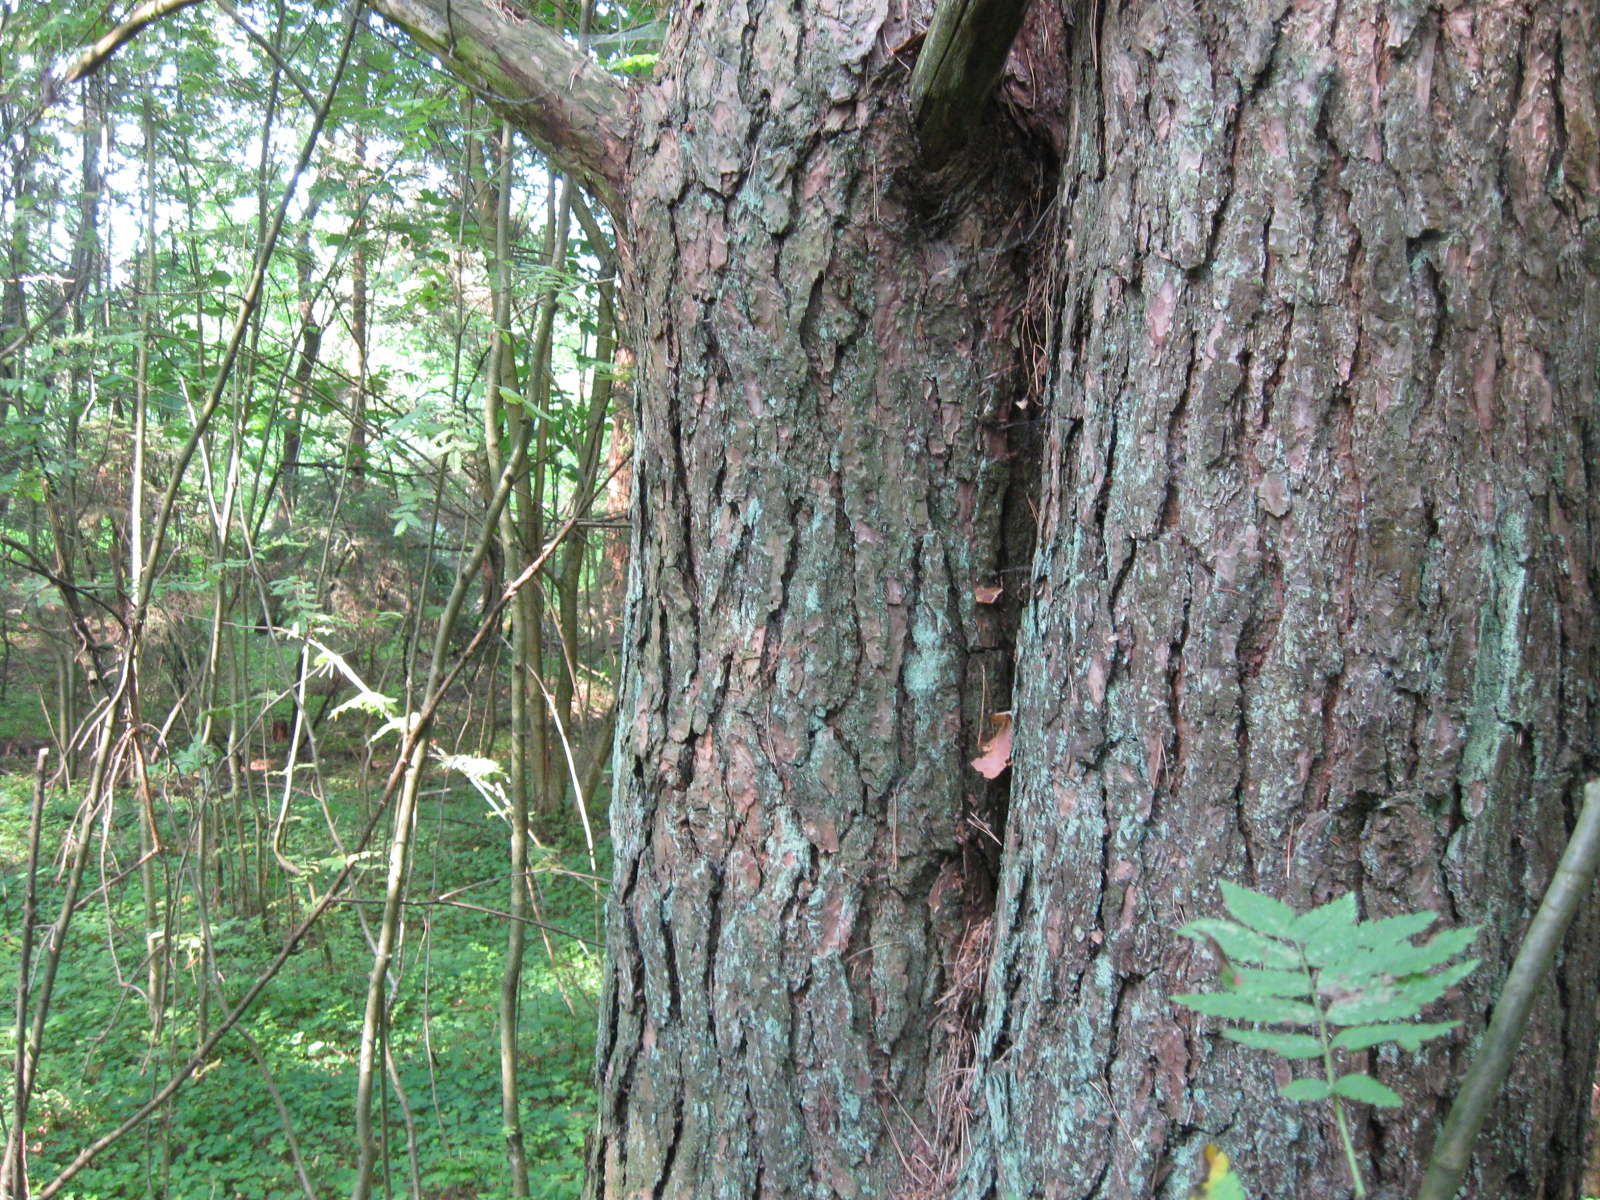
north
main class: Woodland
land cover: Pine dominated coniferous woodland
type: hemiboreal forest and nemoral coniferous forest and mixed broadleaved-coniferous forest
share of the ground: > 75 %
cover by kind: coniferous forest trees 80 %, broadleaved forest trees 15 %, shrubs 5 %
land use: Forestry
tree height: > 5 m
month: August
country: LT
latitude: 54.7546
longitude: 23.3638
